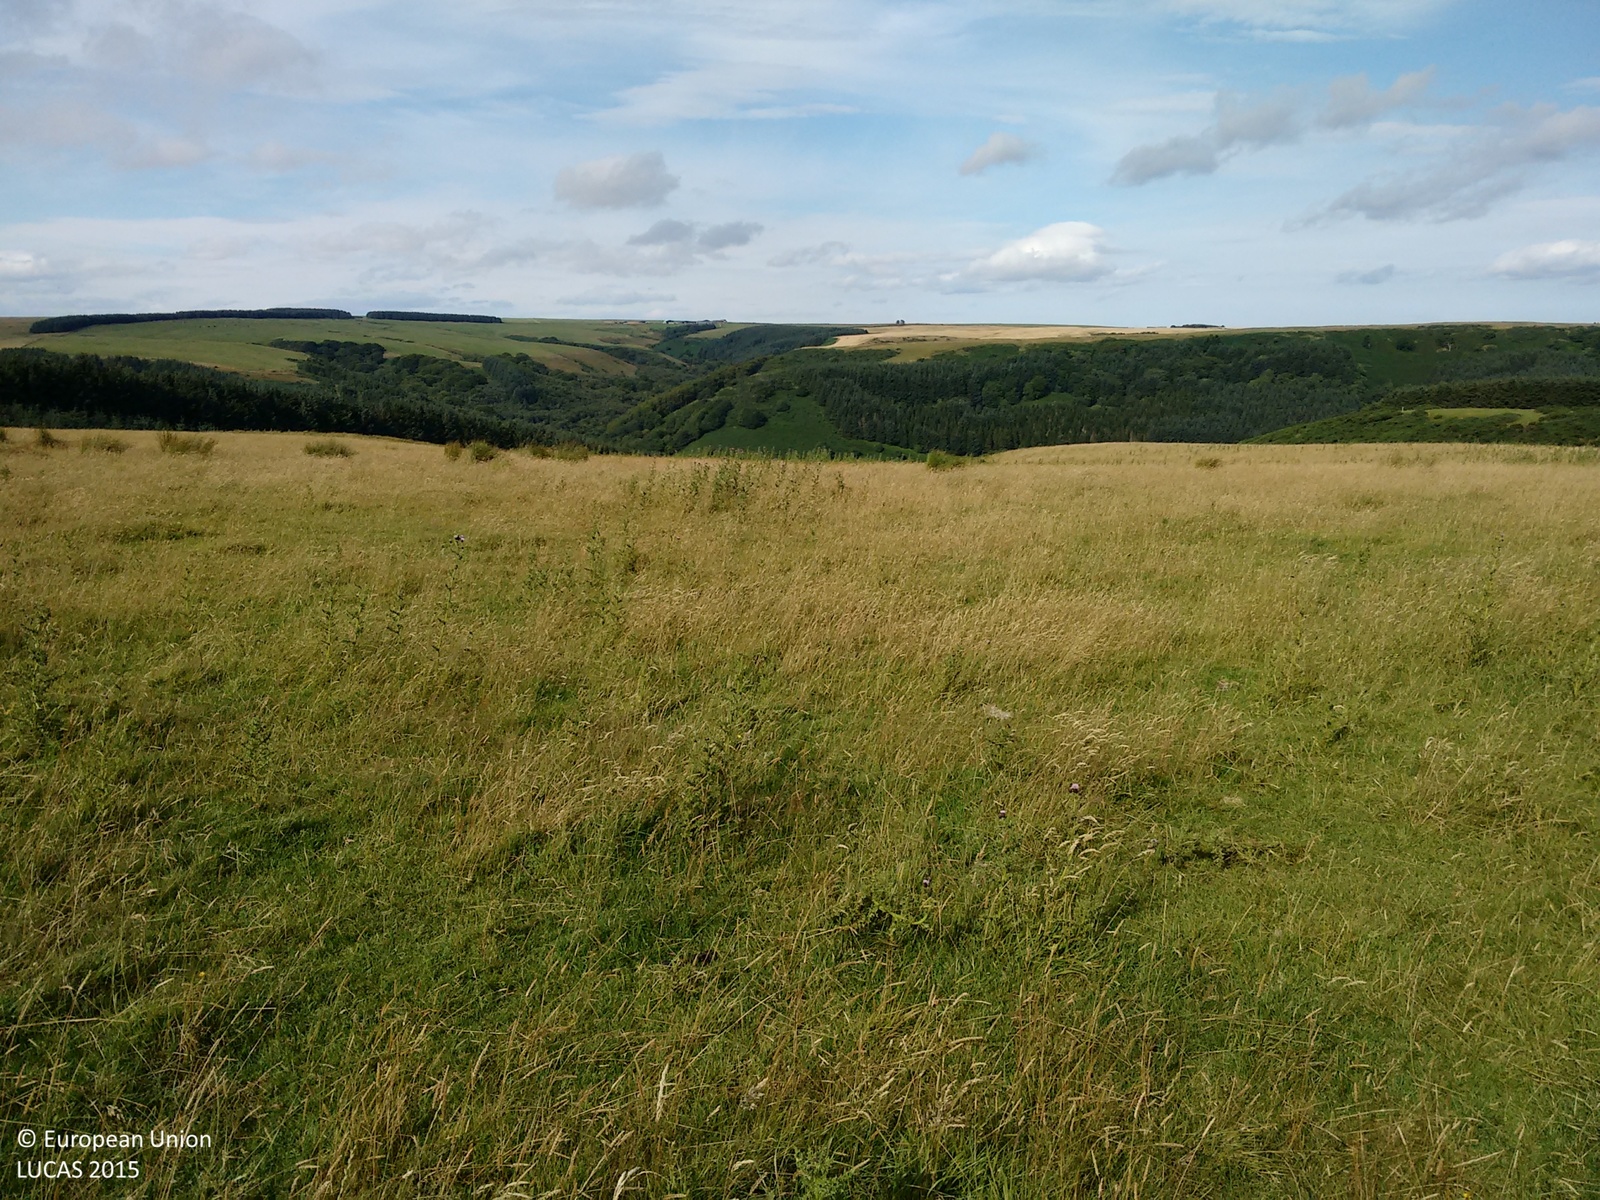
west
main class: Grassland
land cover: Grassland without tree/shrub cover
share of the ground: > 75 %
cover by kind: herbaceous plants 100 %
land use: Agriculture (excluding fallow land and kitchen gardens)
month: August
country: GB
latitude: 57.6551
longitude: -2.2651
